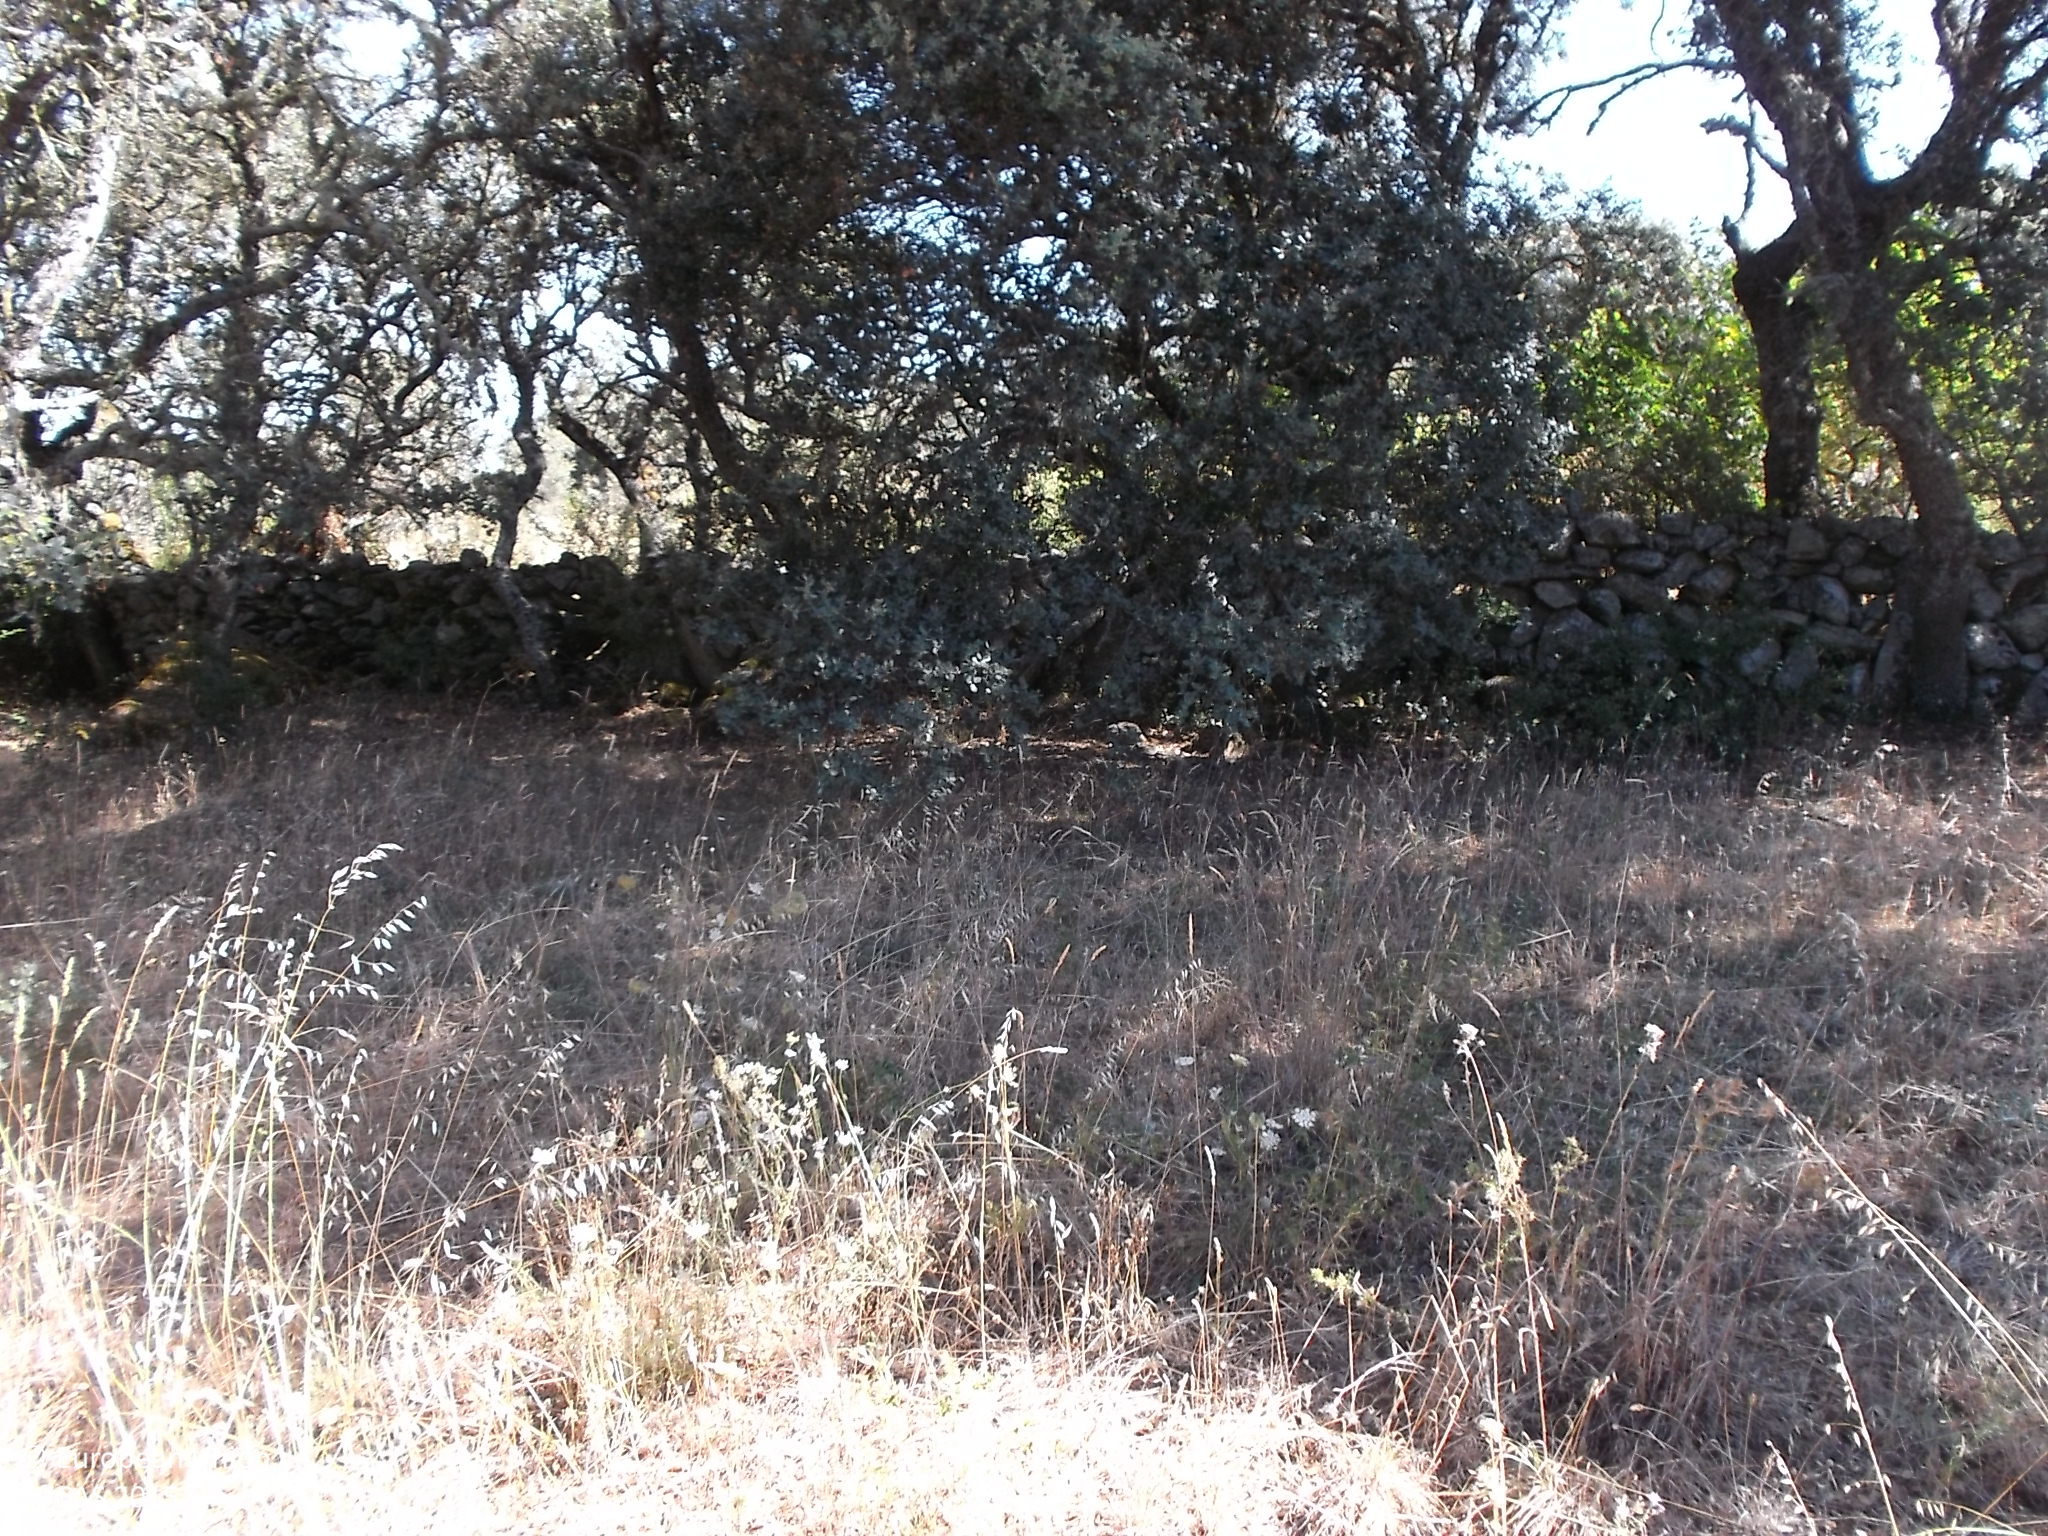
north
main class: Grassland
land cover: Grassland with sparse tree/shrub cover
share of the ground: > 75 %
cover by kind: herbaceous plants 90 %, broadleaved forest trees 5 %, shrubs 5 %
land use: Agriculture (excluding fallow land and kitchen gardens)
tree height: > 5 m
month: July
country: ES
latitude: 41.5014
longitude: -6.1110
